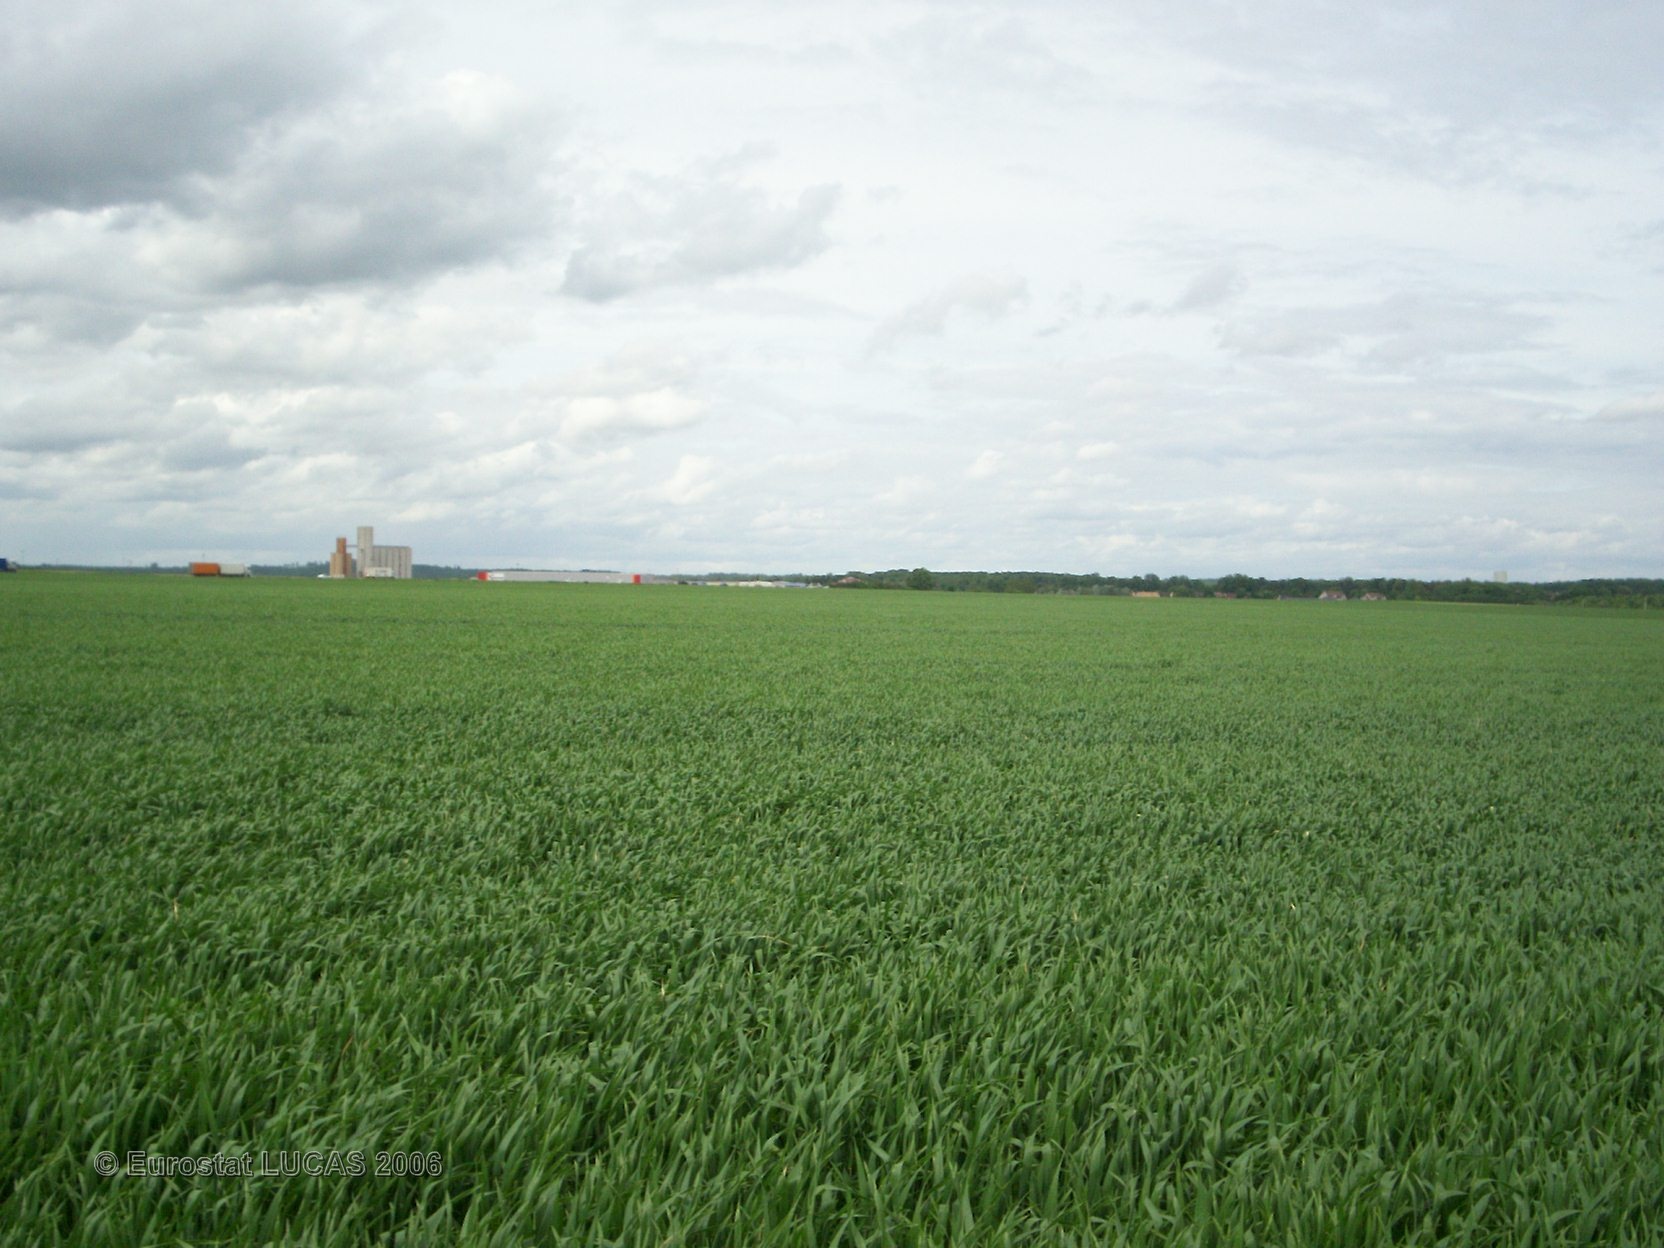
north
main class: Cropland
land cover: Common wheat
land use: Agriculture (excluding fallow land and kitchen gardens)
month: May
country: FR
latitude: 49.1256
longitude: 2.7957
